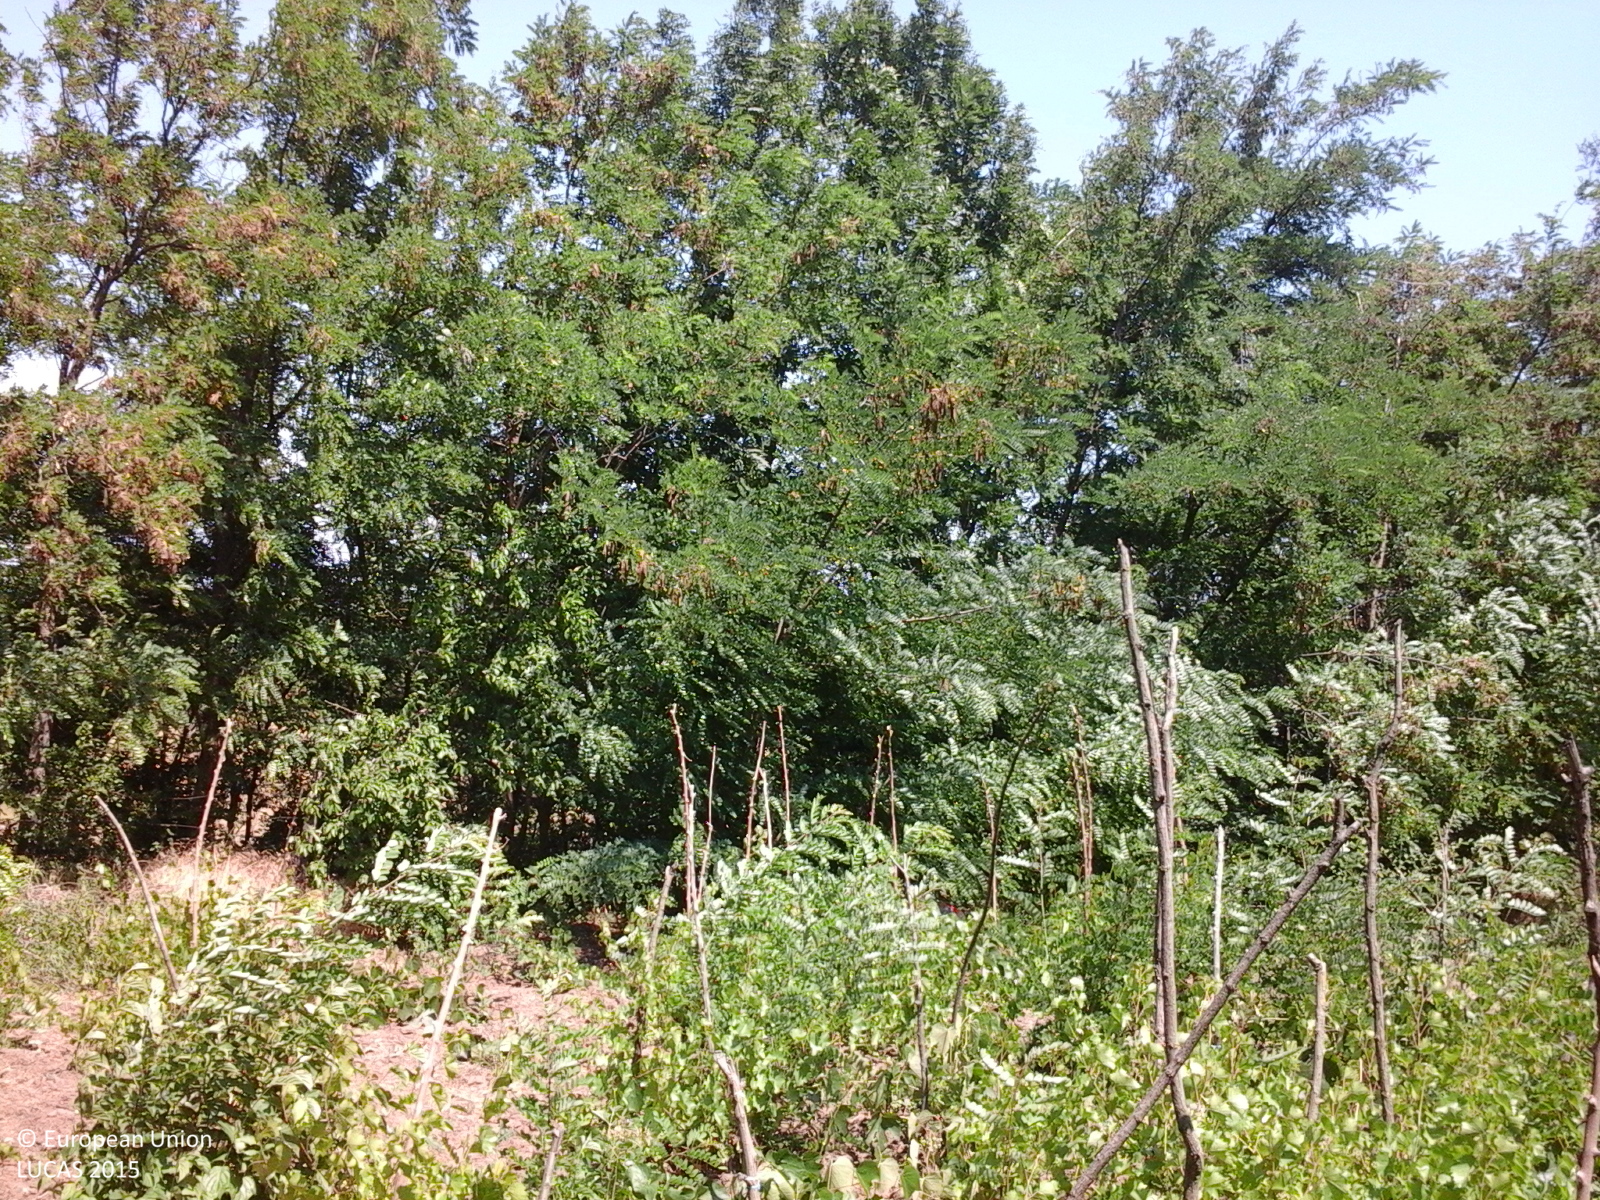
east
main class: Cropland
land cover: Vineyards
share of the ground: > 75 %
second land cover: Other bare soil
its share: > 75 %
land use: Kitchen garden
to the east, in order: Vineyards; Other bare soil; Abandoned hedges; Fences; Abandoned hedges; Spontaneously vegetated surfaces; Maize; Grass margins; Fences; Tracks; Grass margins; Abandoned hedges; Spontaneously vegetated surfaces
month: June
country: RO
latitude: 46.8968
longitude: 28.0753
